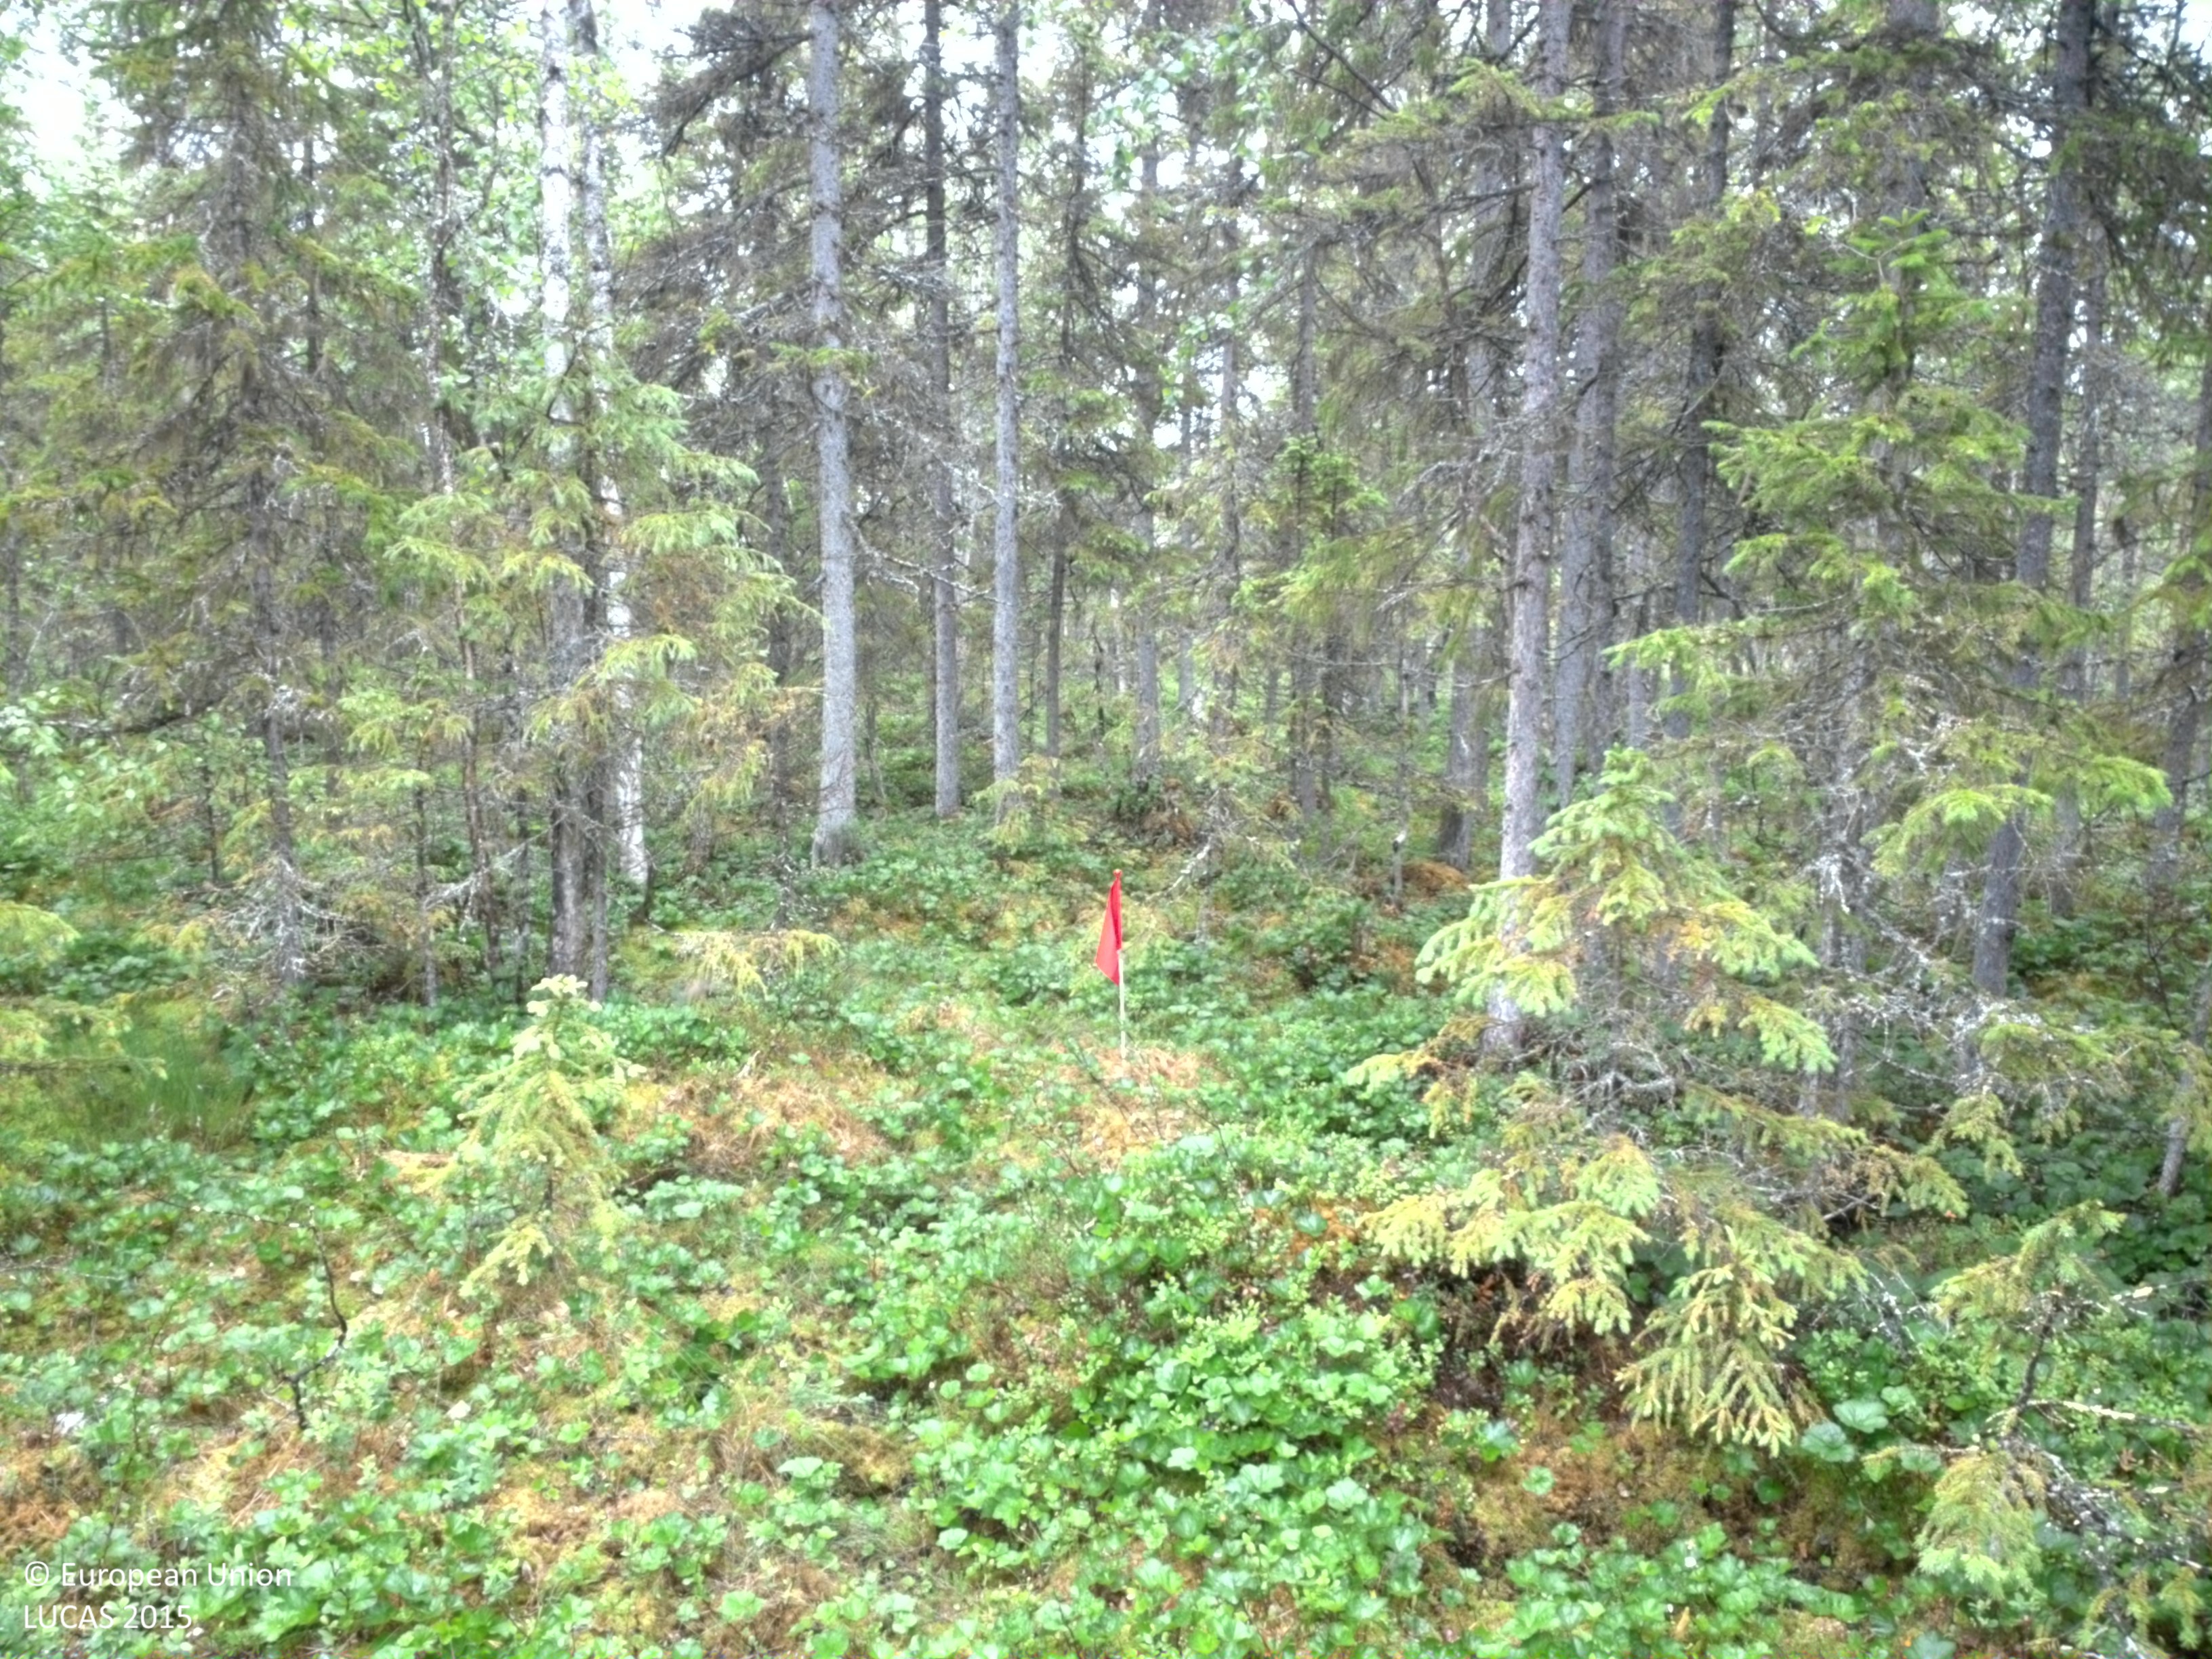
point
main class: Woodland
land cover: Spruce dominated mixed woodland
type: mire and swamp forests
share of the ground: 50 - 75 %
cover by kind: coniferous forest trees 45 %, lichens and mosses 20 %, broadleaved forest trees 15 %, shrubs 10 %, herbaceous plants 10 %
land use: Forestry
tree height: > 5 m
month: July
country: SE
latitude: 64.5628
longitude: 18.2931
